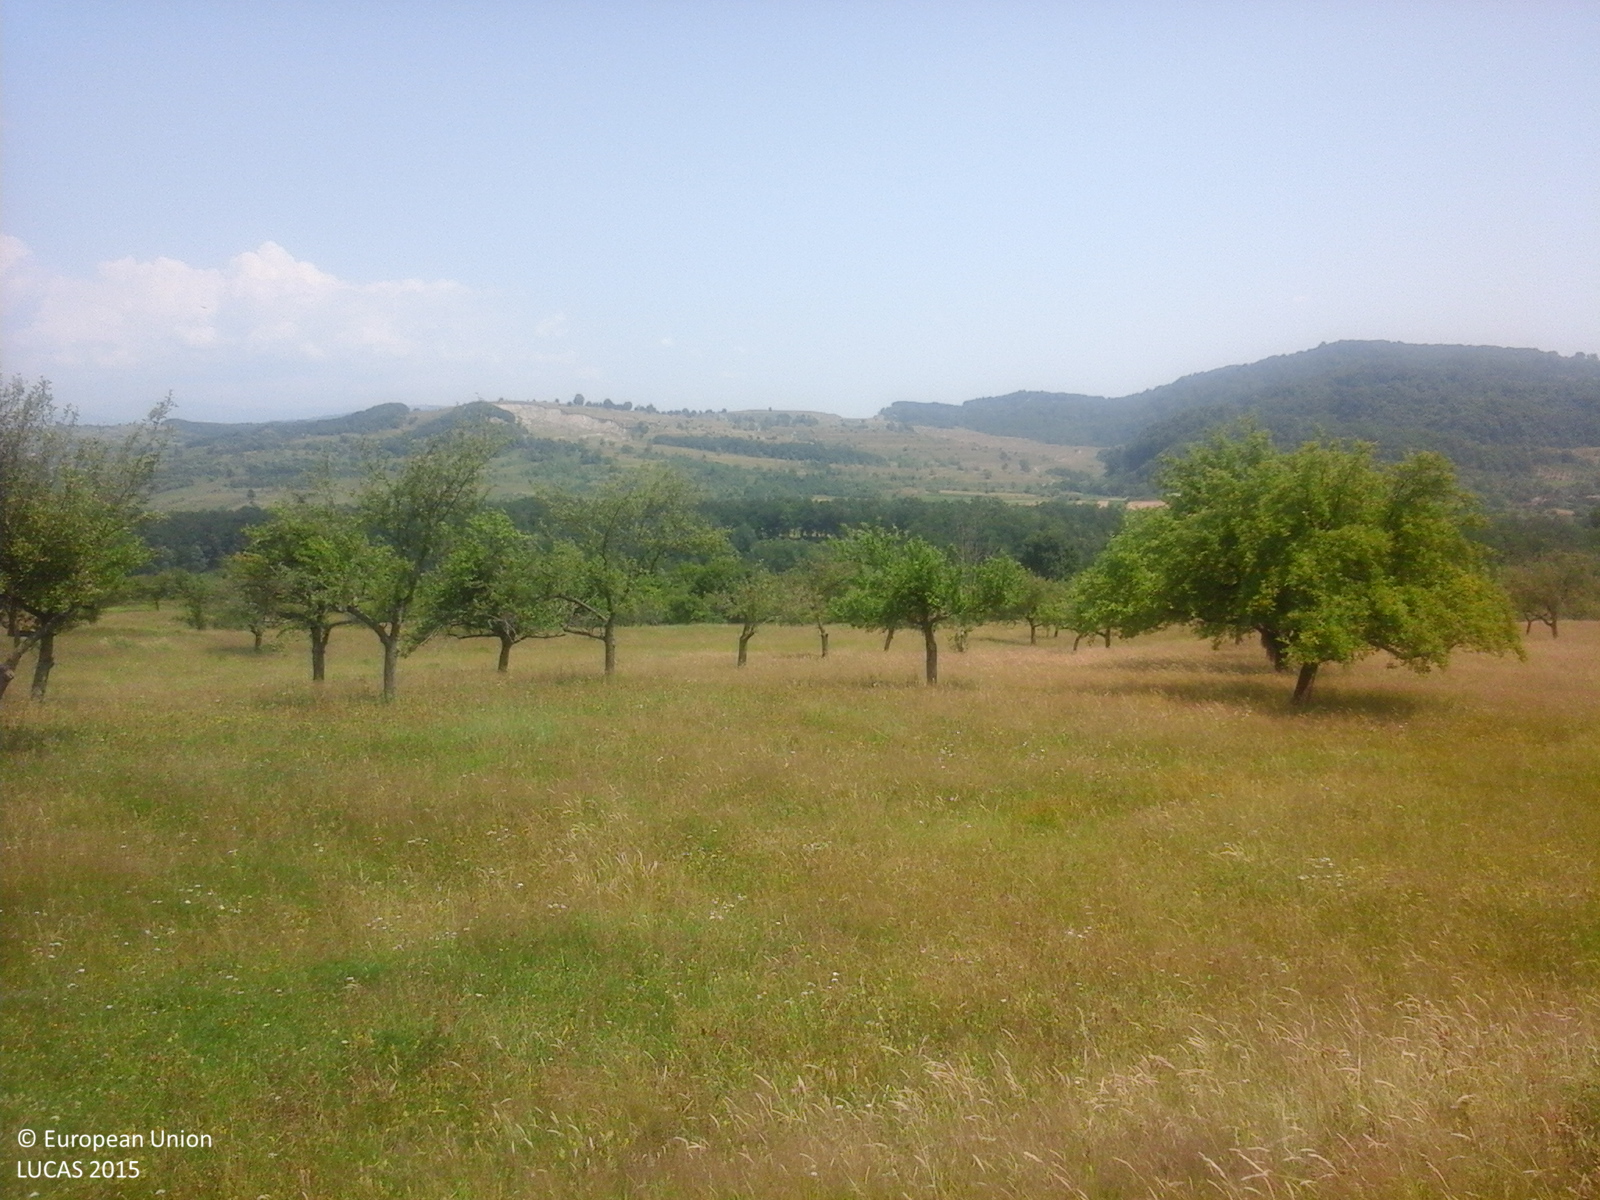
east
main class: Cropland
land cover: Apple fruit
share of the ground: 50 - 75 %
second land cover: Grassland without tree/shrub cover
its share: > 75 %
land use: Agriculture (excluding fallow land and kitchen gardens)
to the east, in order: Apple fruit; Grassland without tree/shrub cover; Tracks; Apple fruit; Broadleaved woodland; Apple fruit
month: July
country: RO
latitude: 45.2062
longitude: 24.9179
